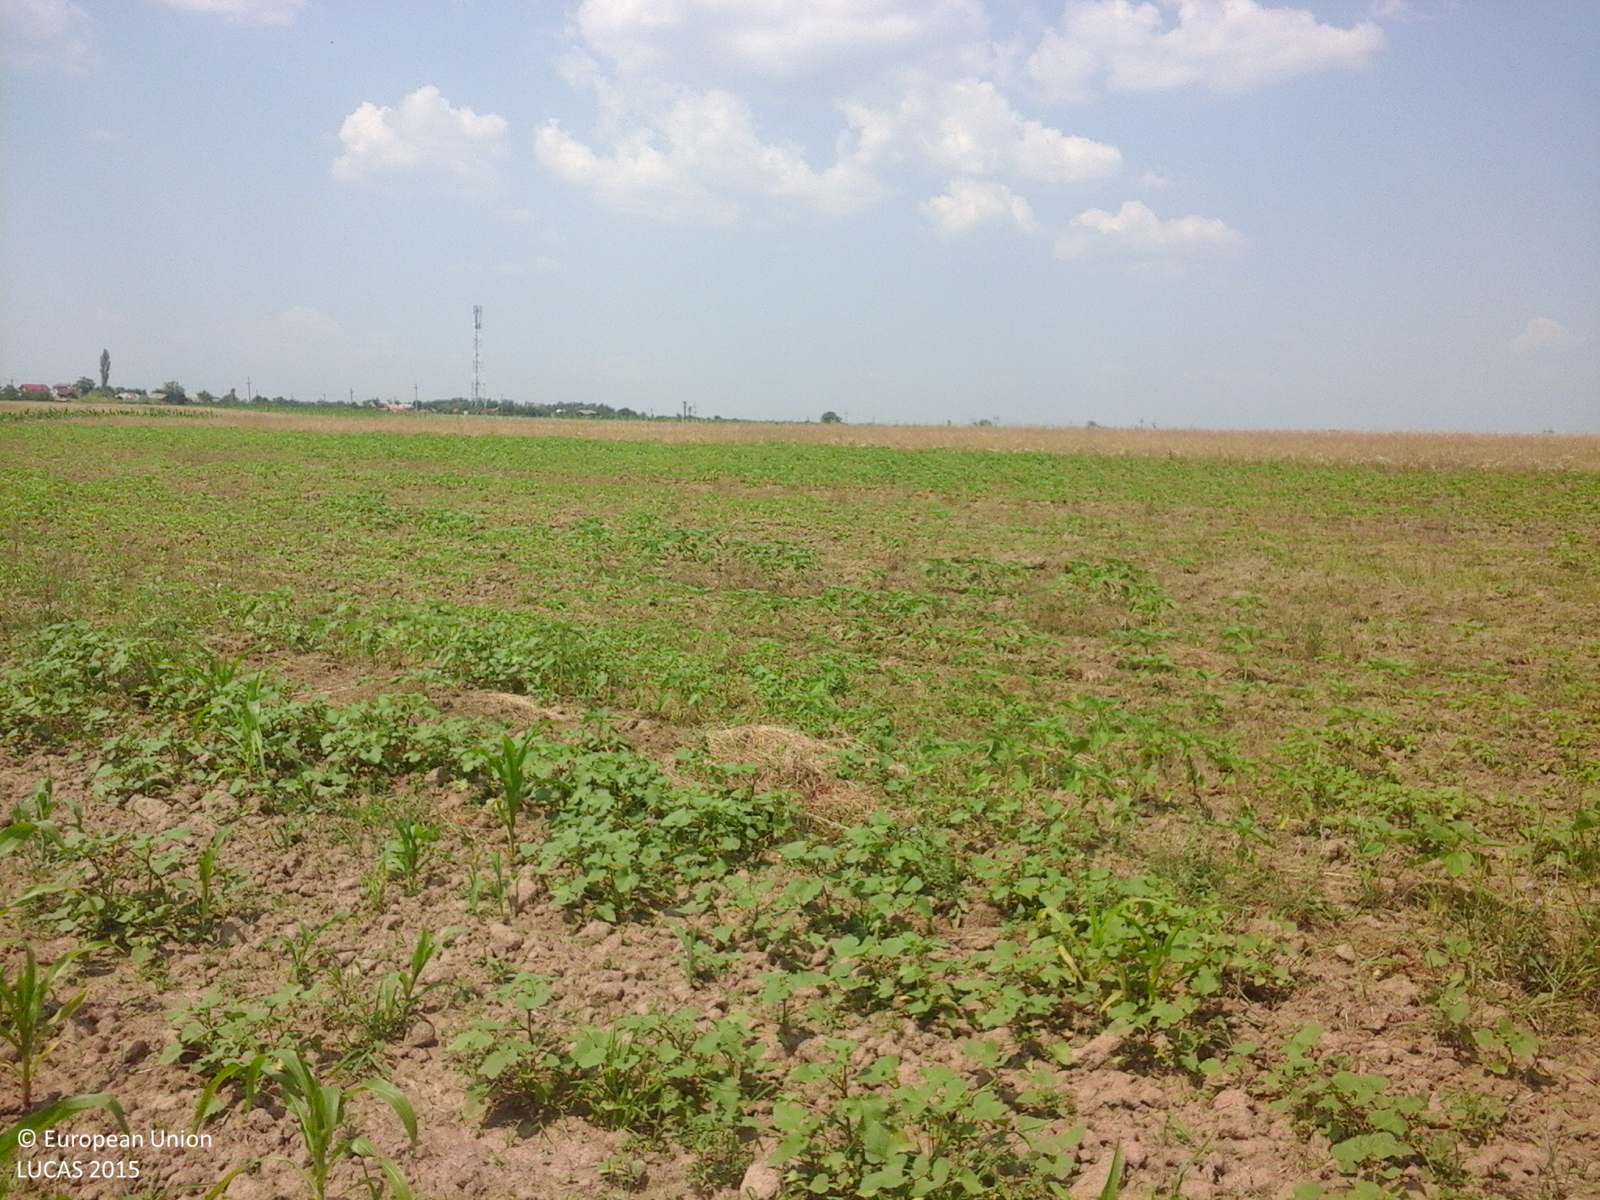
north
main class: Cropland
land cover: Maize
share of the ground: < 10 %
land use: Agriculture (excluding fallow land and kitchen gardens)
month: July
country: RO
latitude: 44.7761
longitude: 24.4661
